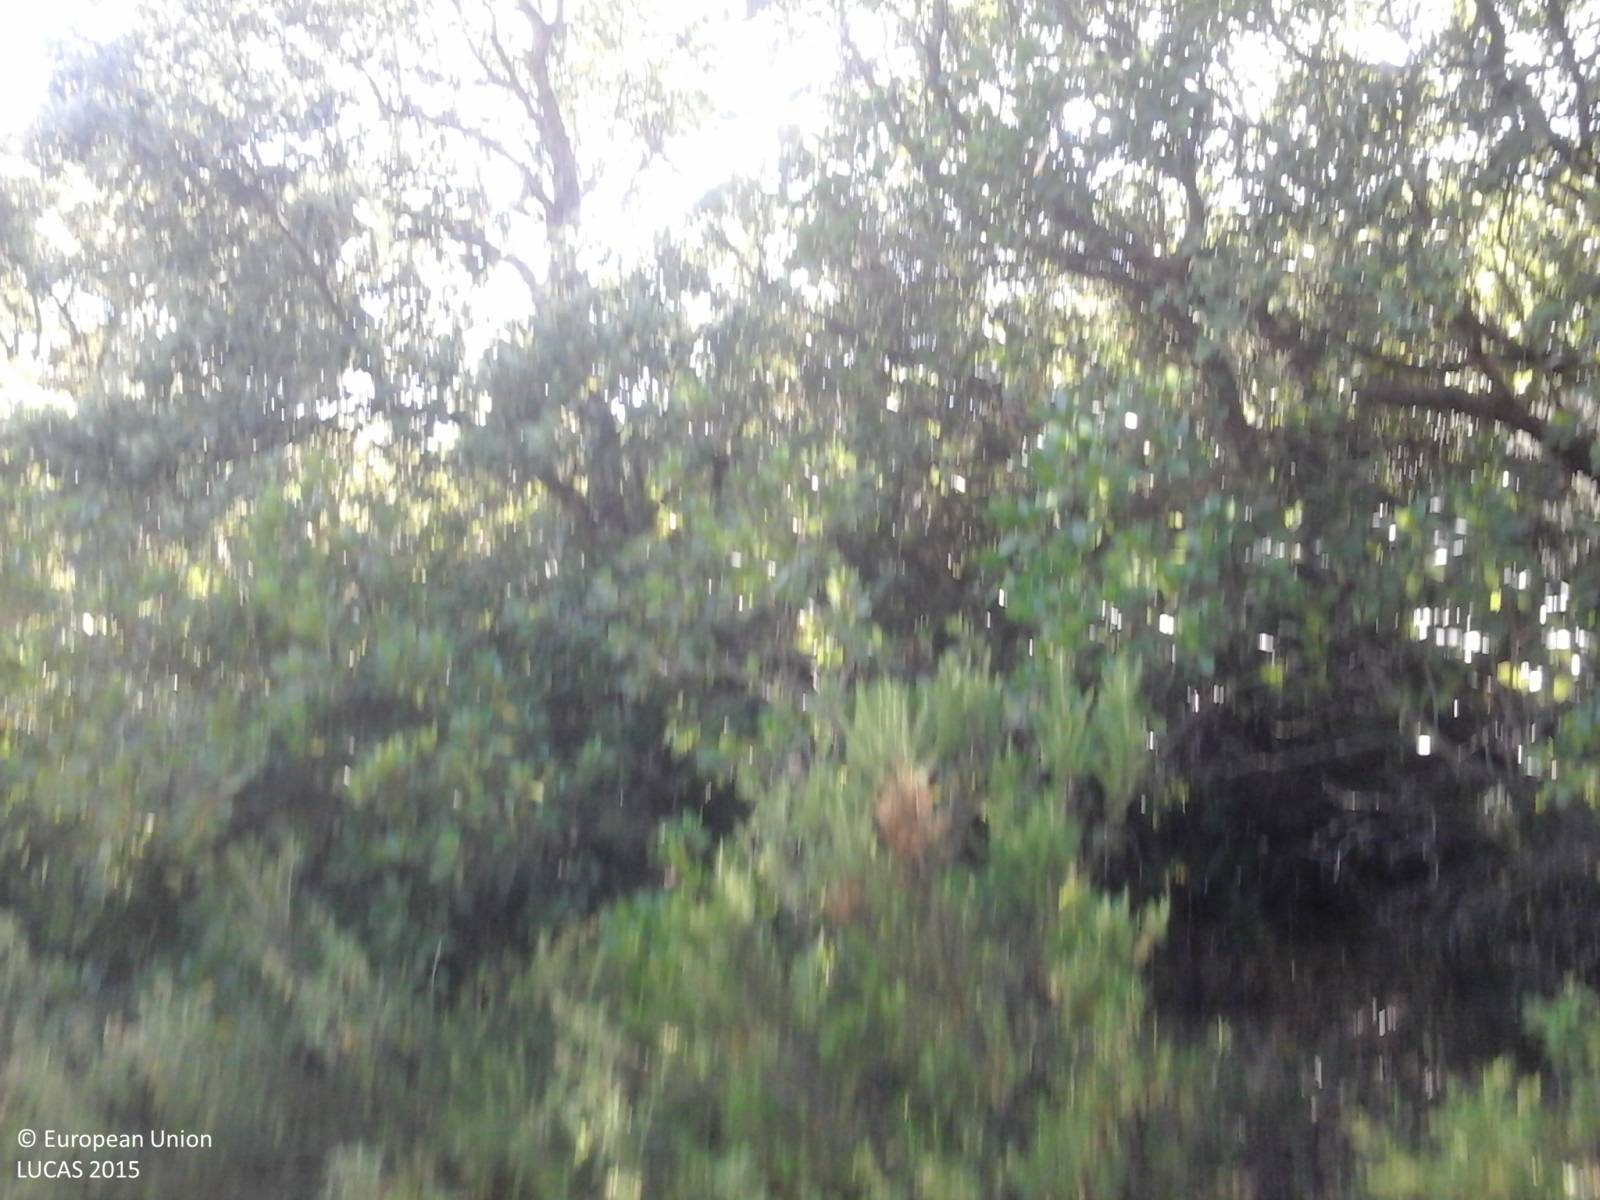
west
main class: Shrubland
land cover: Shrubland with sparse tree cover
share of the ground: > 75 %
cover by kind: shrubs 95 %, broadleaved forest trees 5 %
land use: Semi-natural and natural areas not in use
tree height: > 5 m
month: June
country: IT
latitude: 39.1909
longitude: 8.7688
